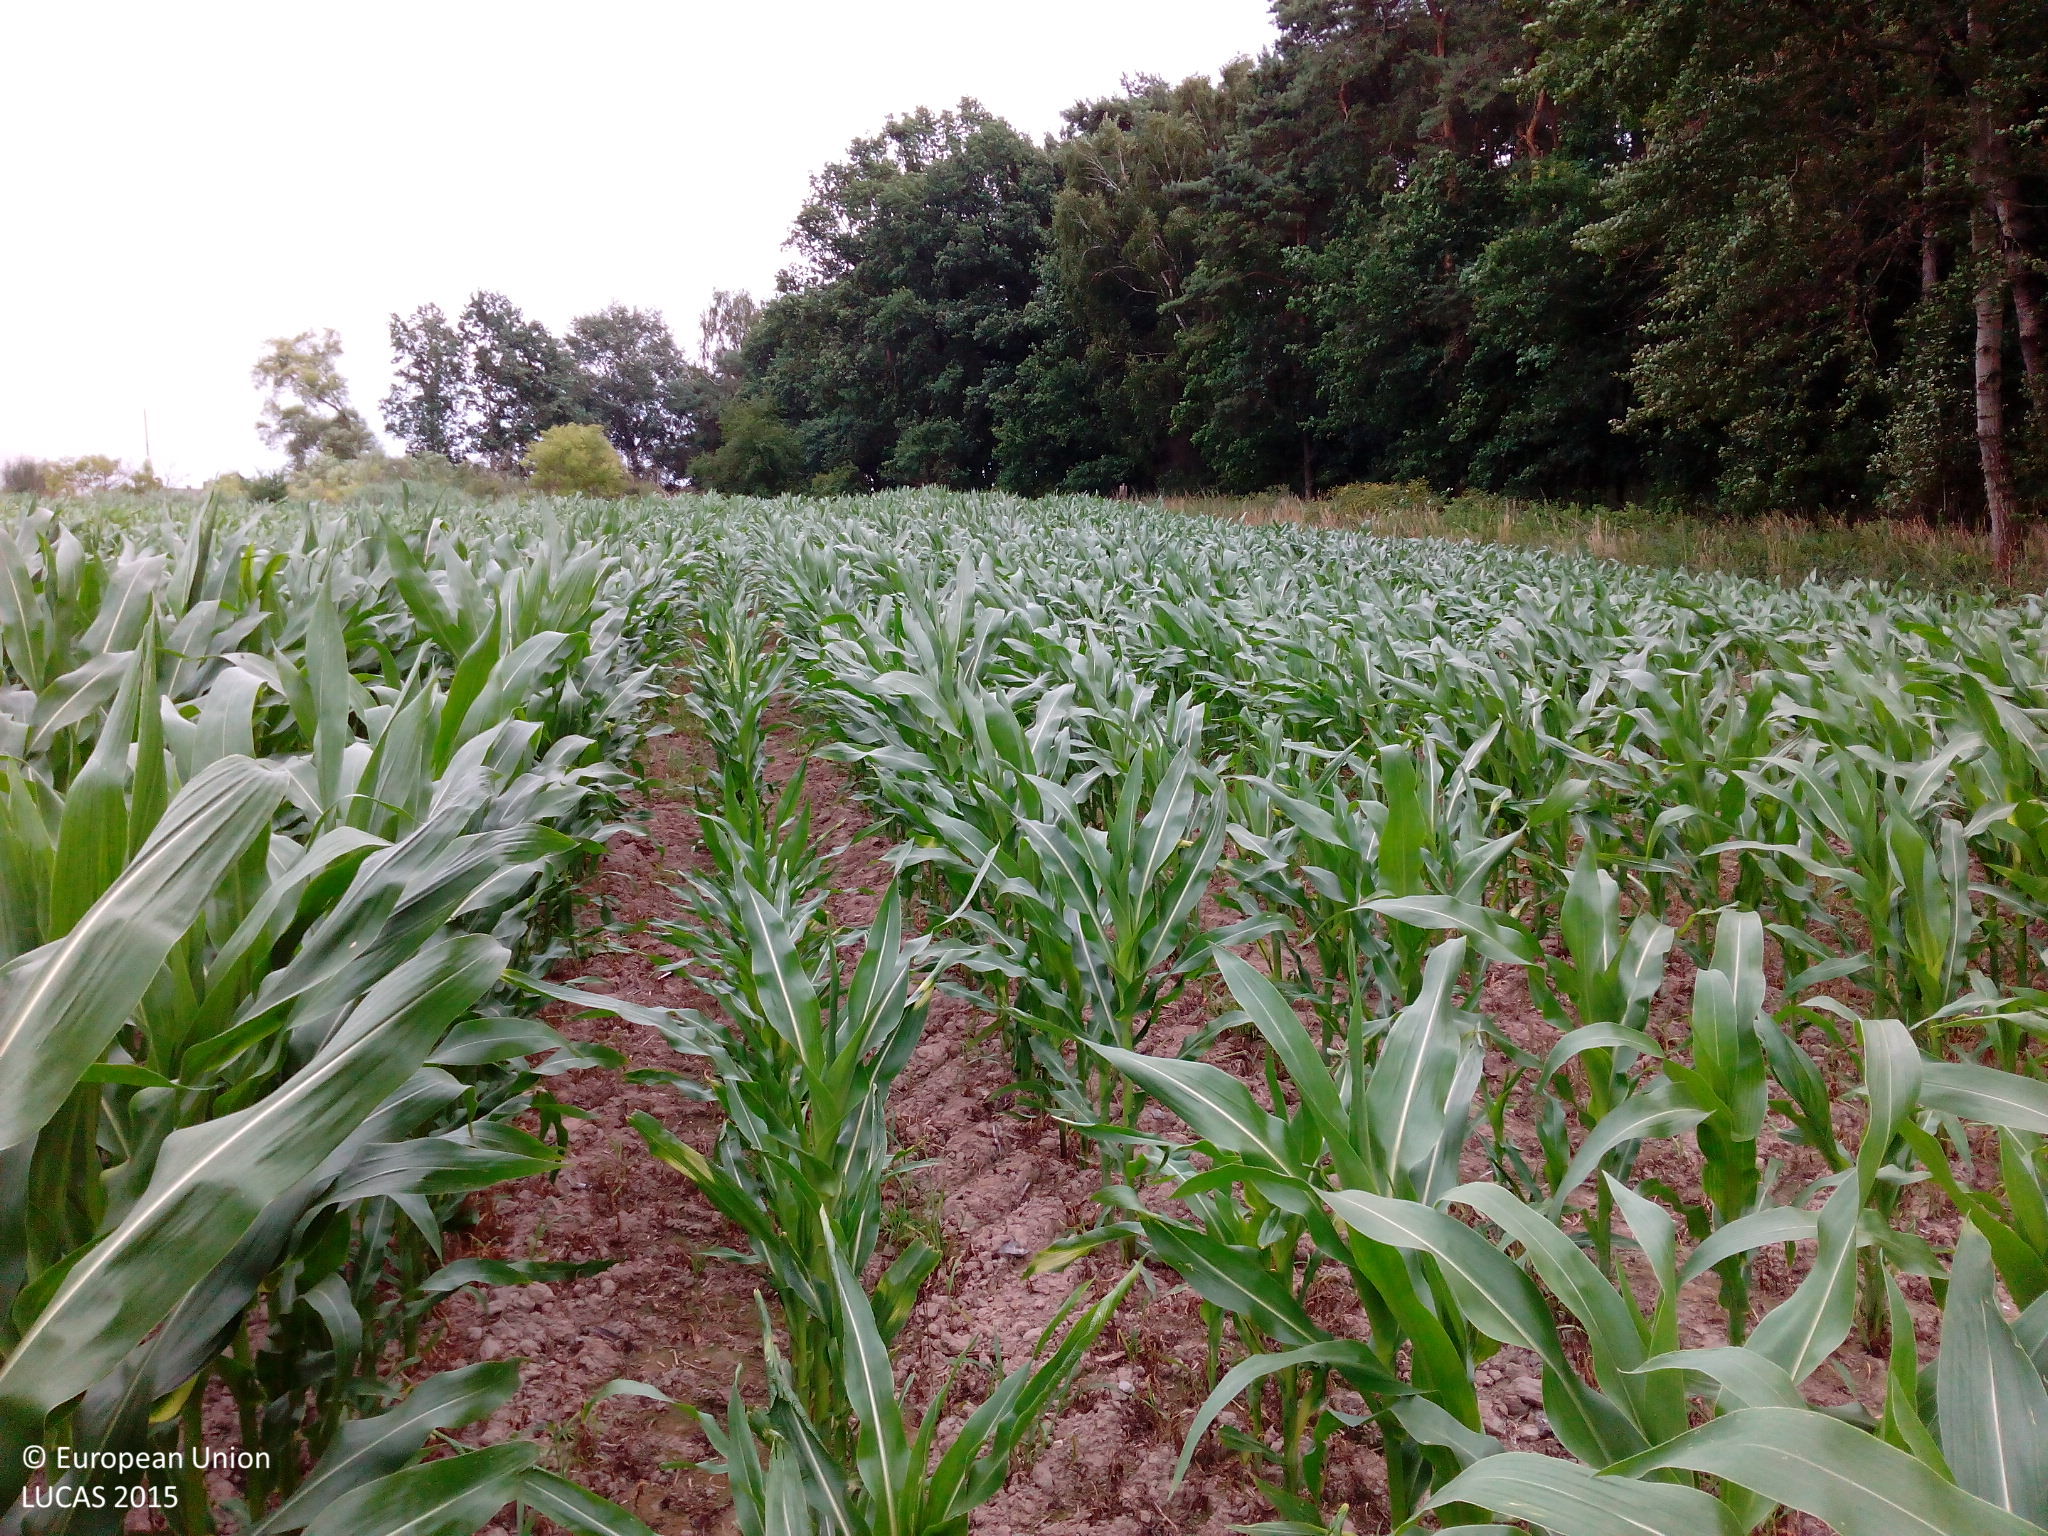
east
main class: Cropland
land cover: Maize
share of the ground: > 75 %
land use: Agriculture (excluding fallow land and kitchen gardens)
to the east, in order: Maize; Grassland without tree/shrub cover; Pine dominated mixed woodland; Tracks; Grassland without tree/shrub cover; Artificial constructions in urban areas
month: July
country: DE
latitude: 52.5212
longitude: 14.1423
